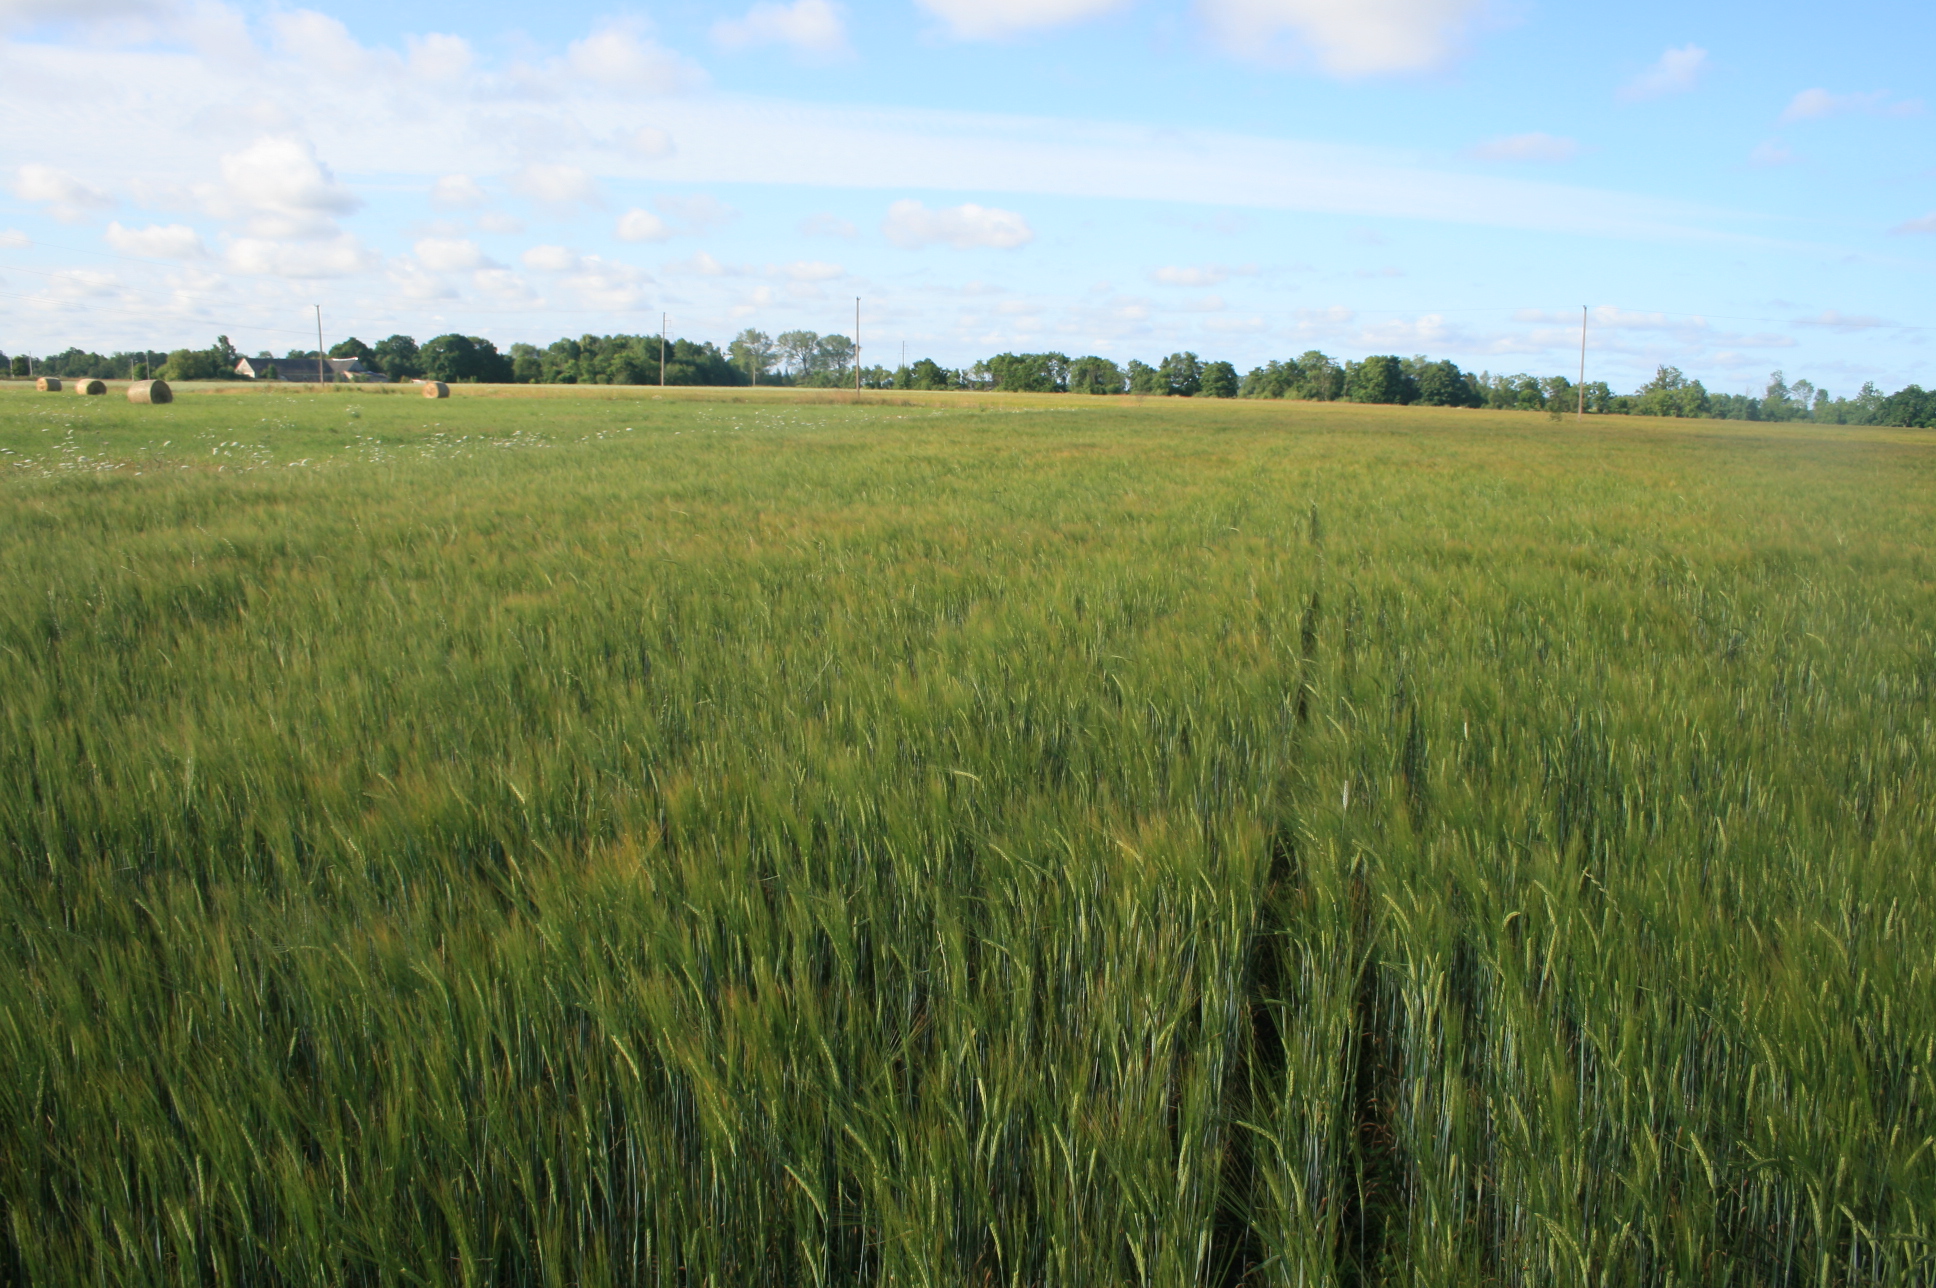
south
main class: Cropland
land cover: Barley
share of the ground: > 75 %
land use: Agriculture (excluding fallow land and kitchen gardens)
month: July
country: LT
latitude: 55.8381
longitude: 21.2346
